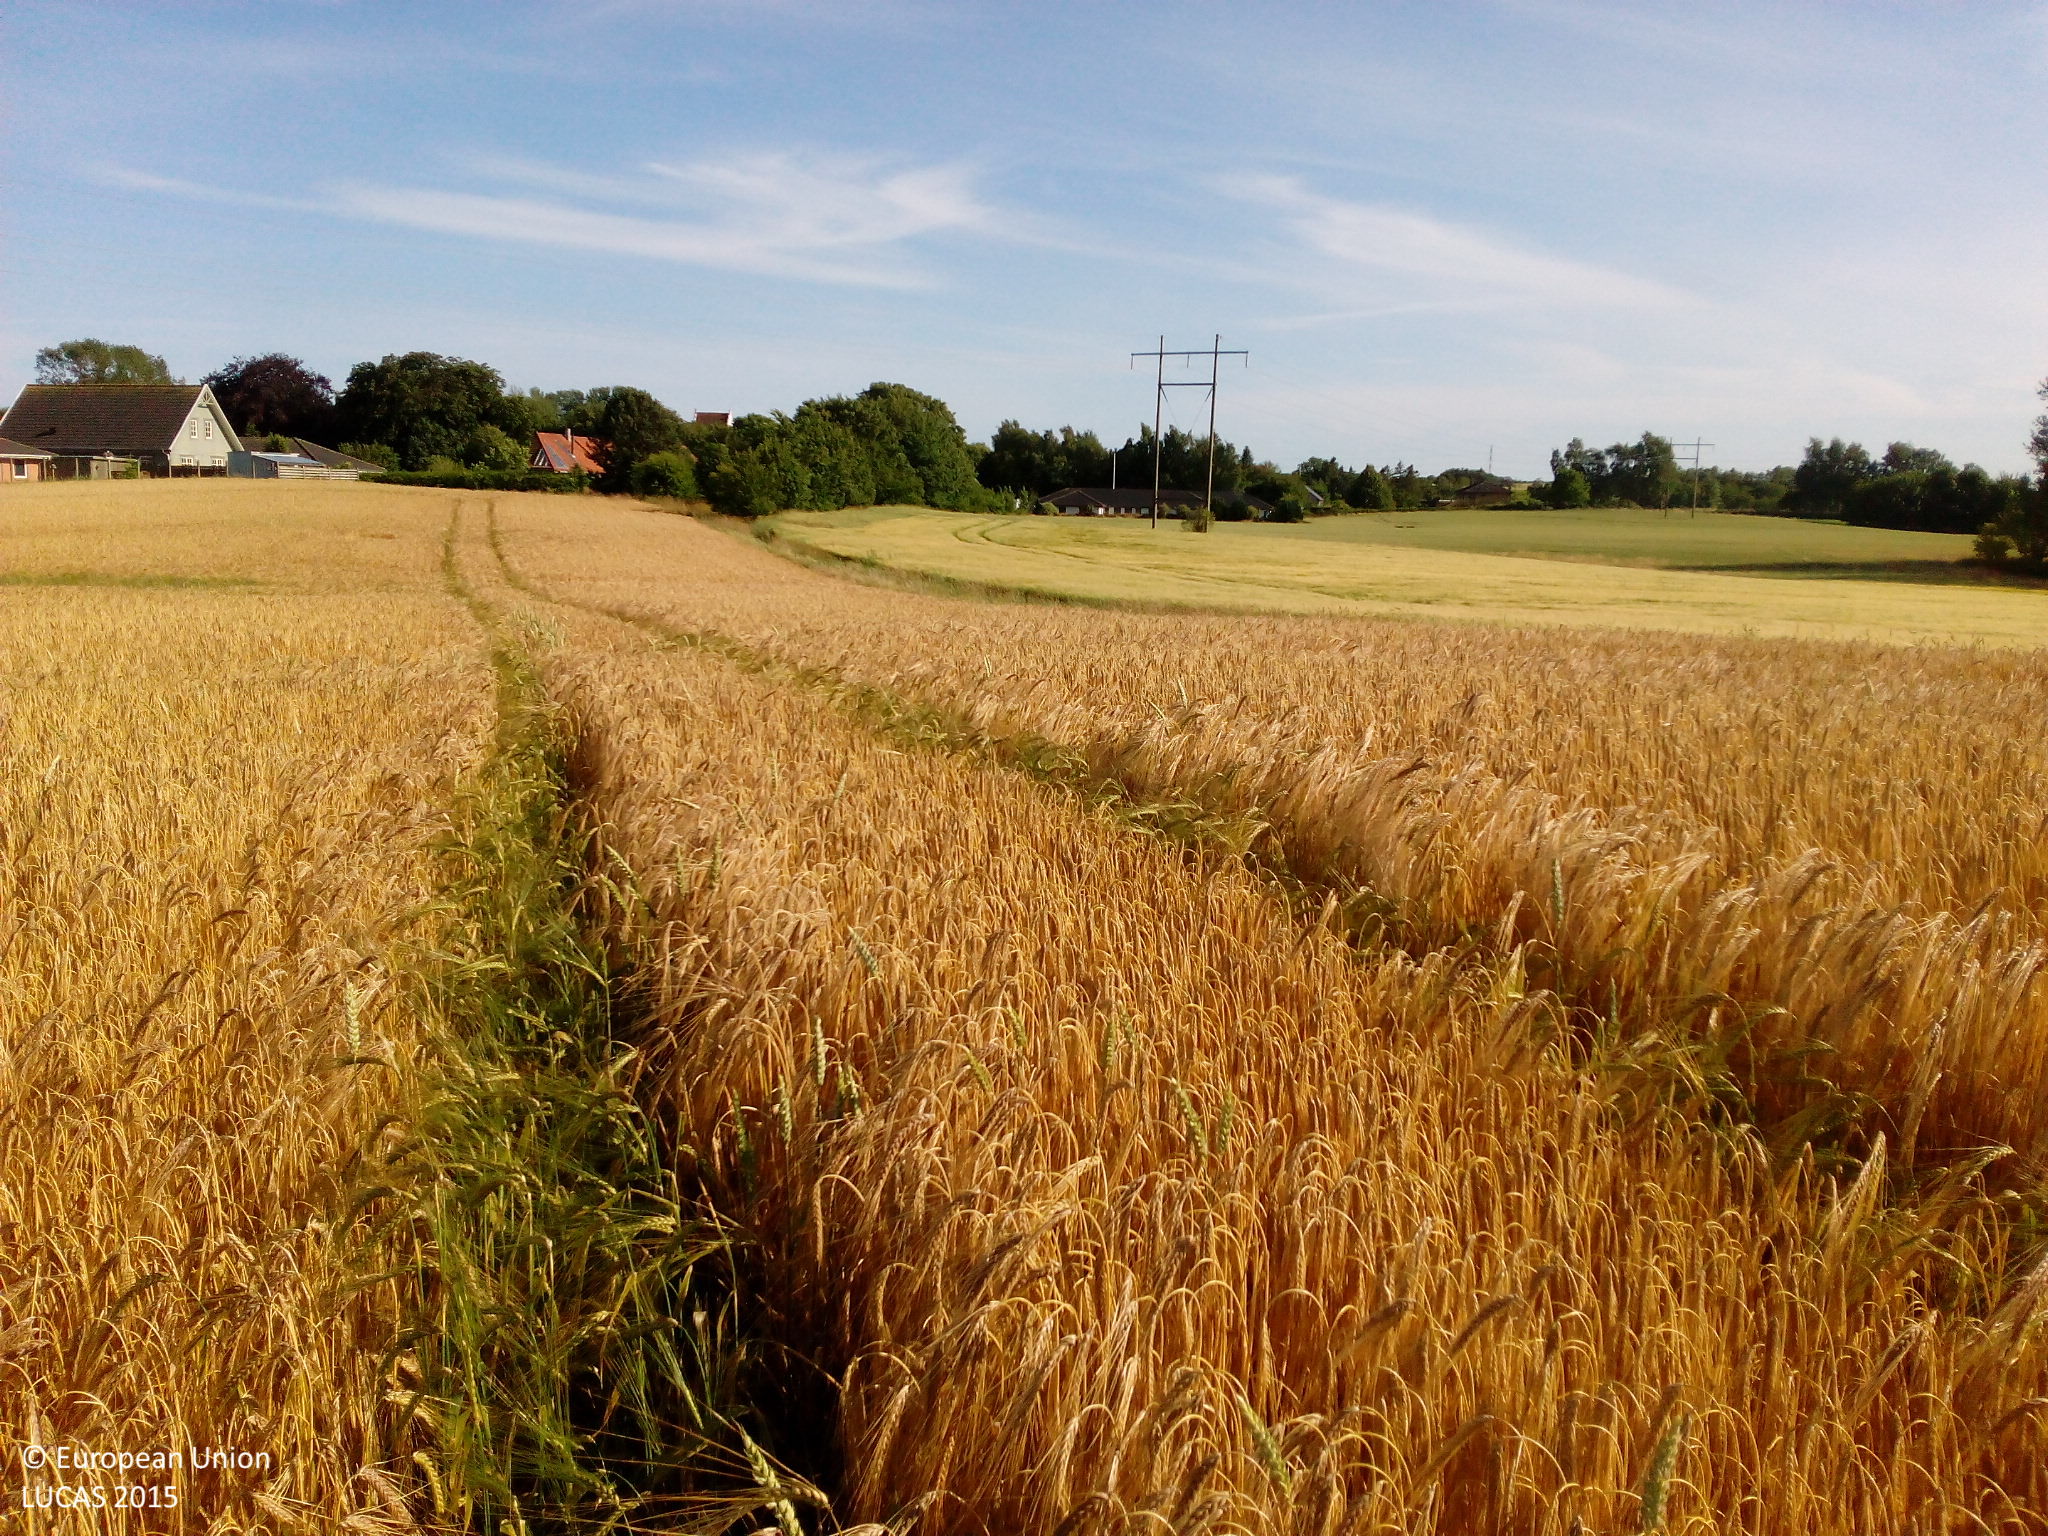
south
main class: Cropland
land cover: Barley
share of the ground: > 75 %
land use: Agriculture (excluding fallow land and kitchen gardens)
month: July
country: DK
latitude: 55.6555
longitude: 11.6673
